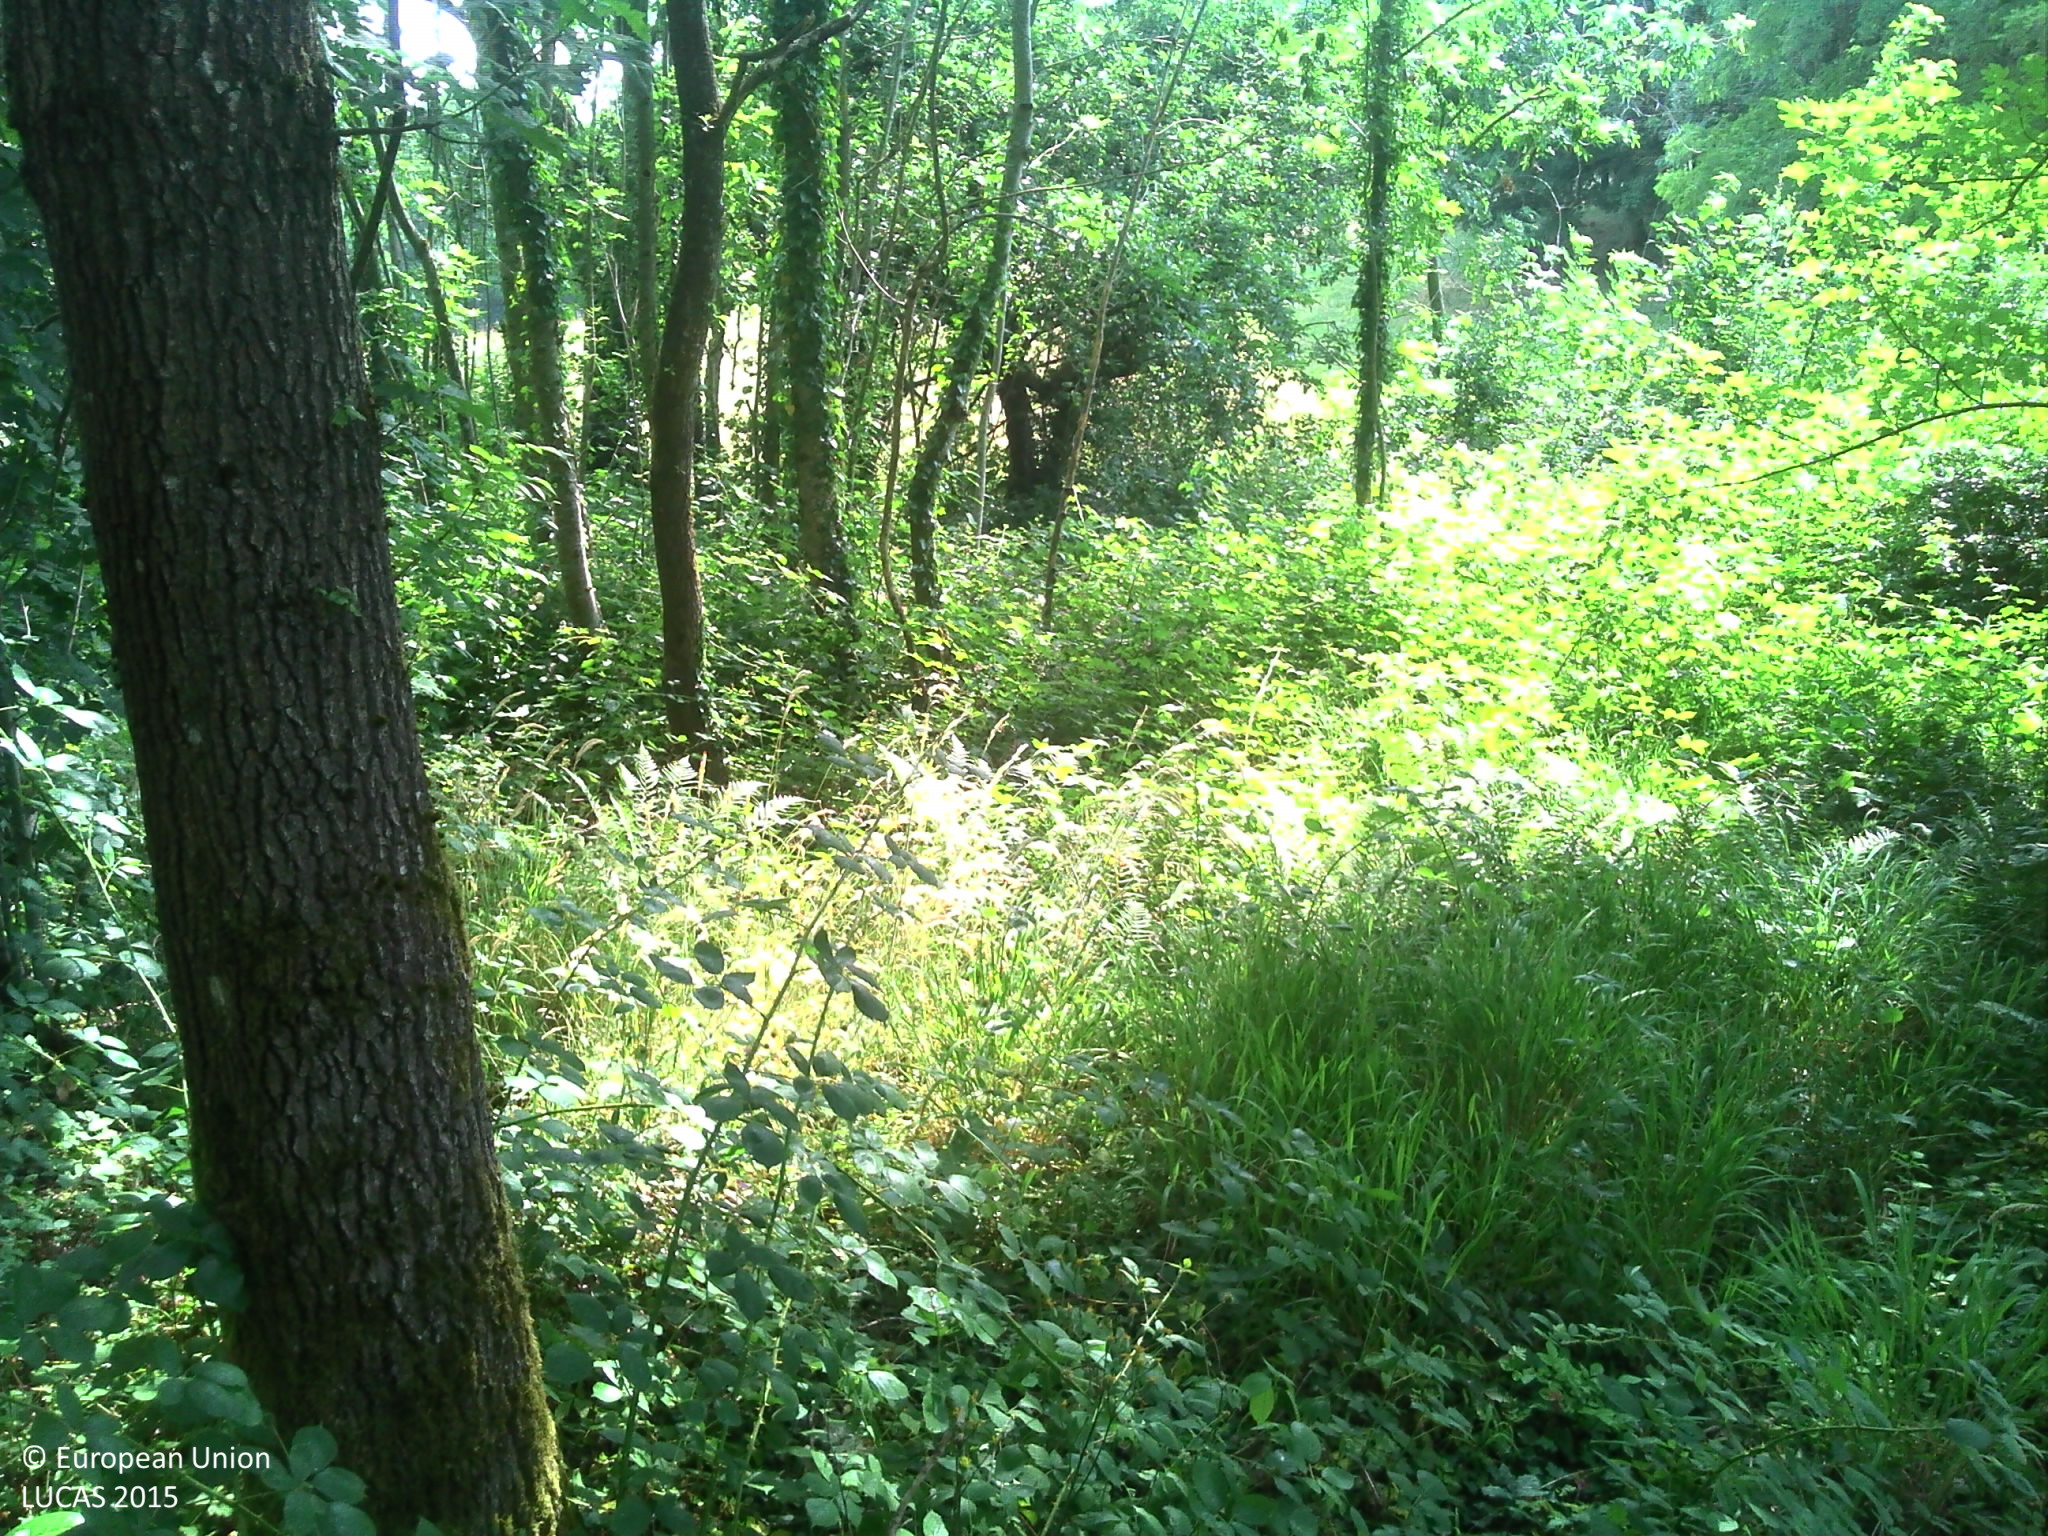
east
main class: Woodland
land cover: Broadleaved woodland
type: mesophytic deciduous forest
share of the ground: > 75 %
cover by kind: broadleaved forest trees 80 %, shrubs 10 %, herbaceous plants 10 %
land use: Forestry
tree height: > 5 m
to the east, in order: Broadleaved woodland; Fences; Ditches and canals; Fences; Grassland without tree/shrub cover; Fences; Grass margins; Tracks; Grass margins; Broadleaved woodland
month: July
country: FR
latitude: 49.1057
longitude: 3.3490
